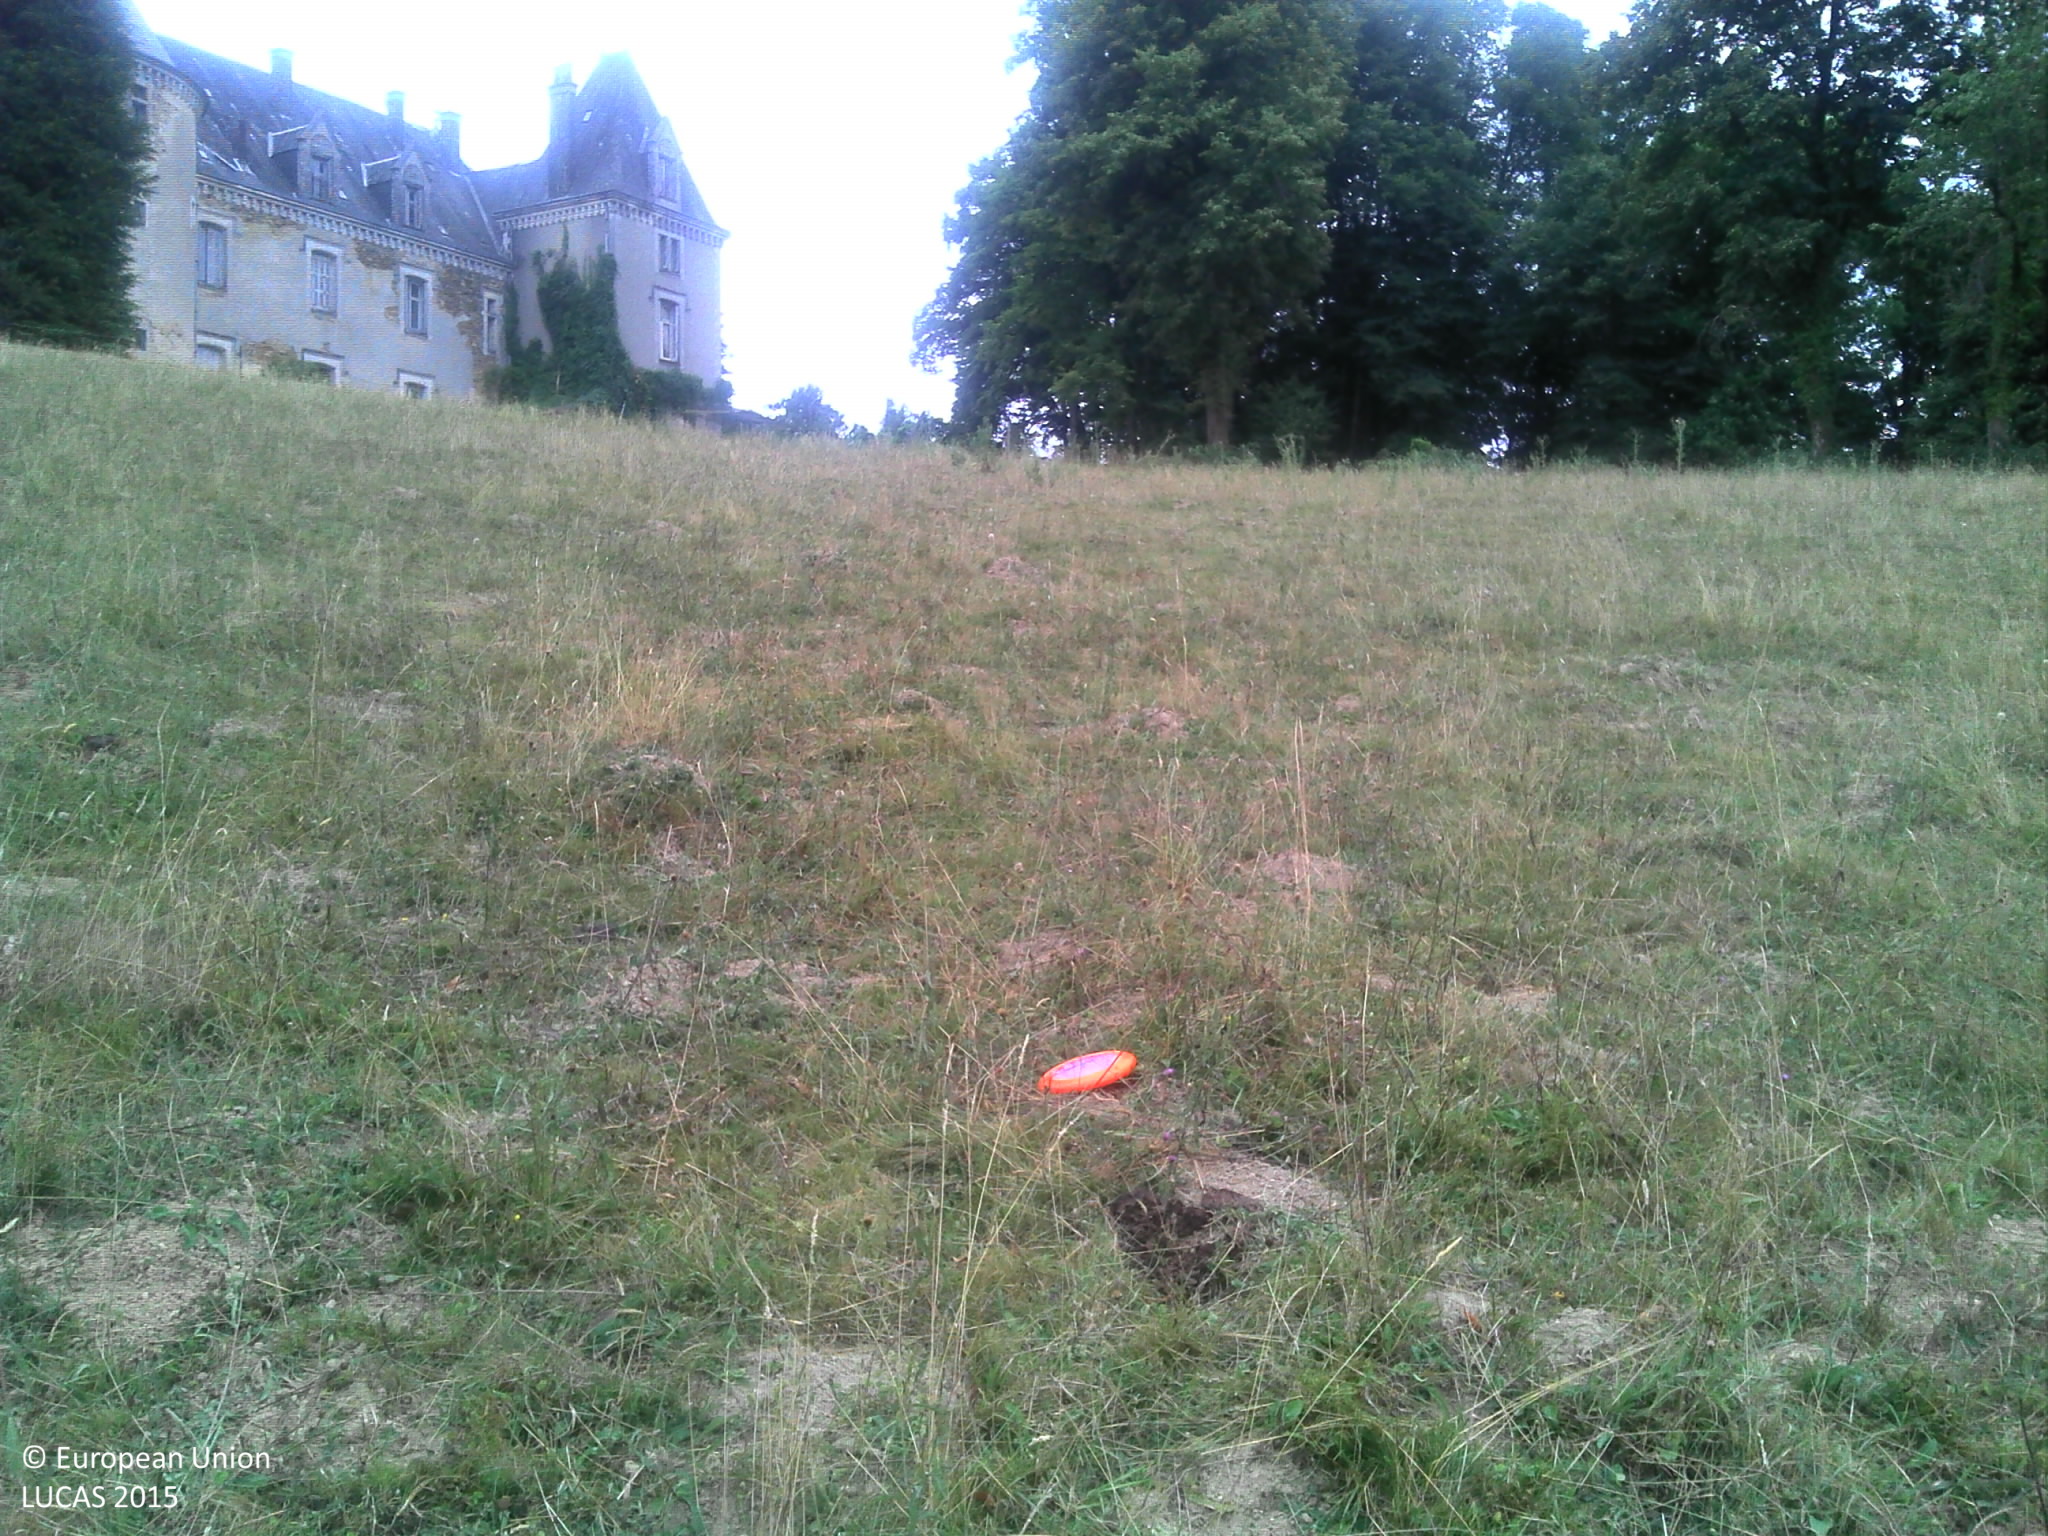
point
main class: Grassland
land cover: Grassland without tree/shrub cover
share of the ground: > 75 %
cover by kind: herbaceous plants 100 %
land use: Agriculture (excluding fallow land and kitchen gardens)
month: July
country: FR
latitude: 45.5218
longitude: 1.4797
